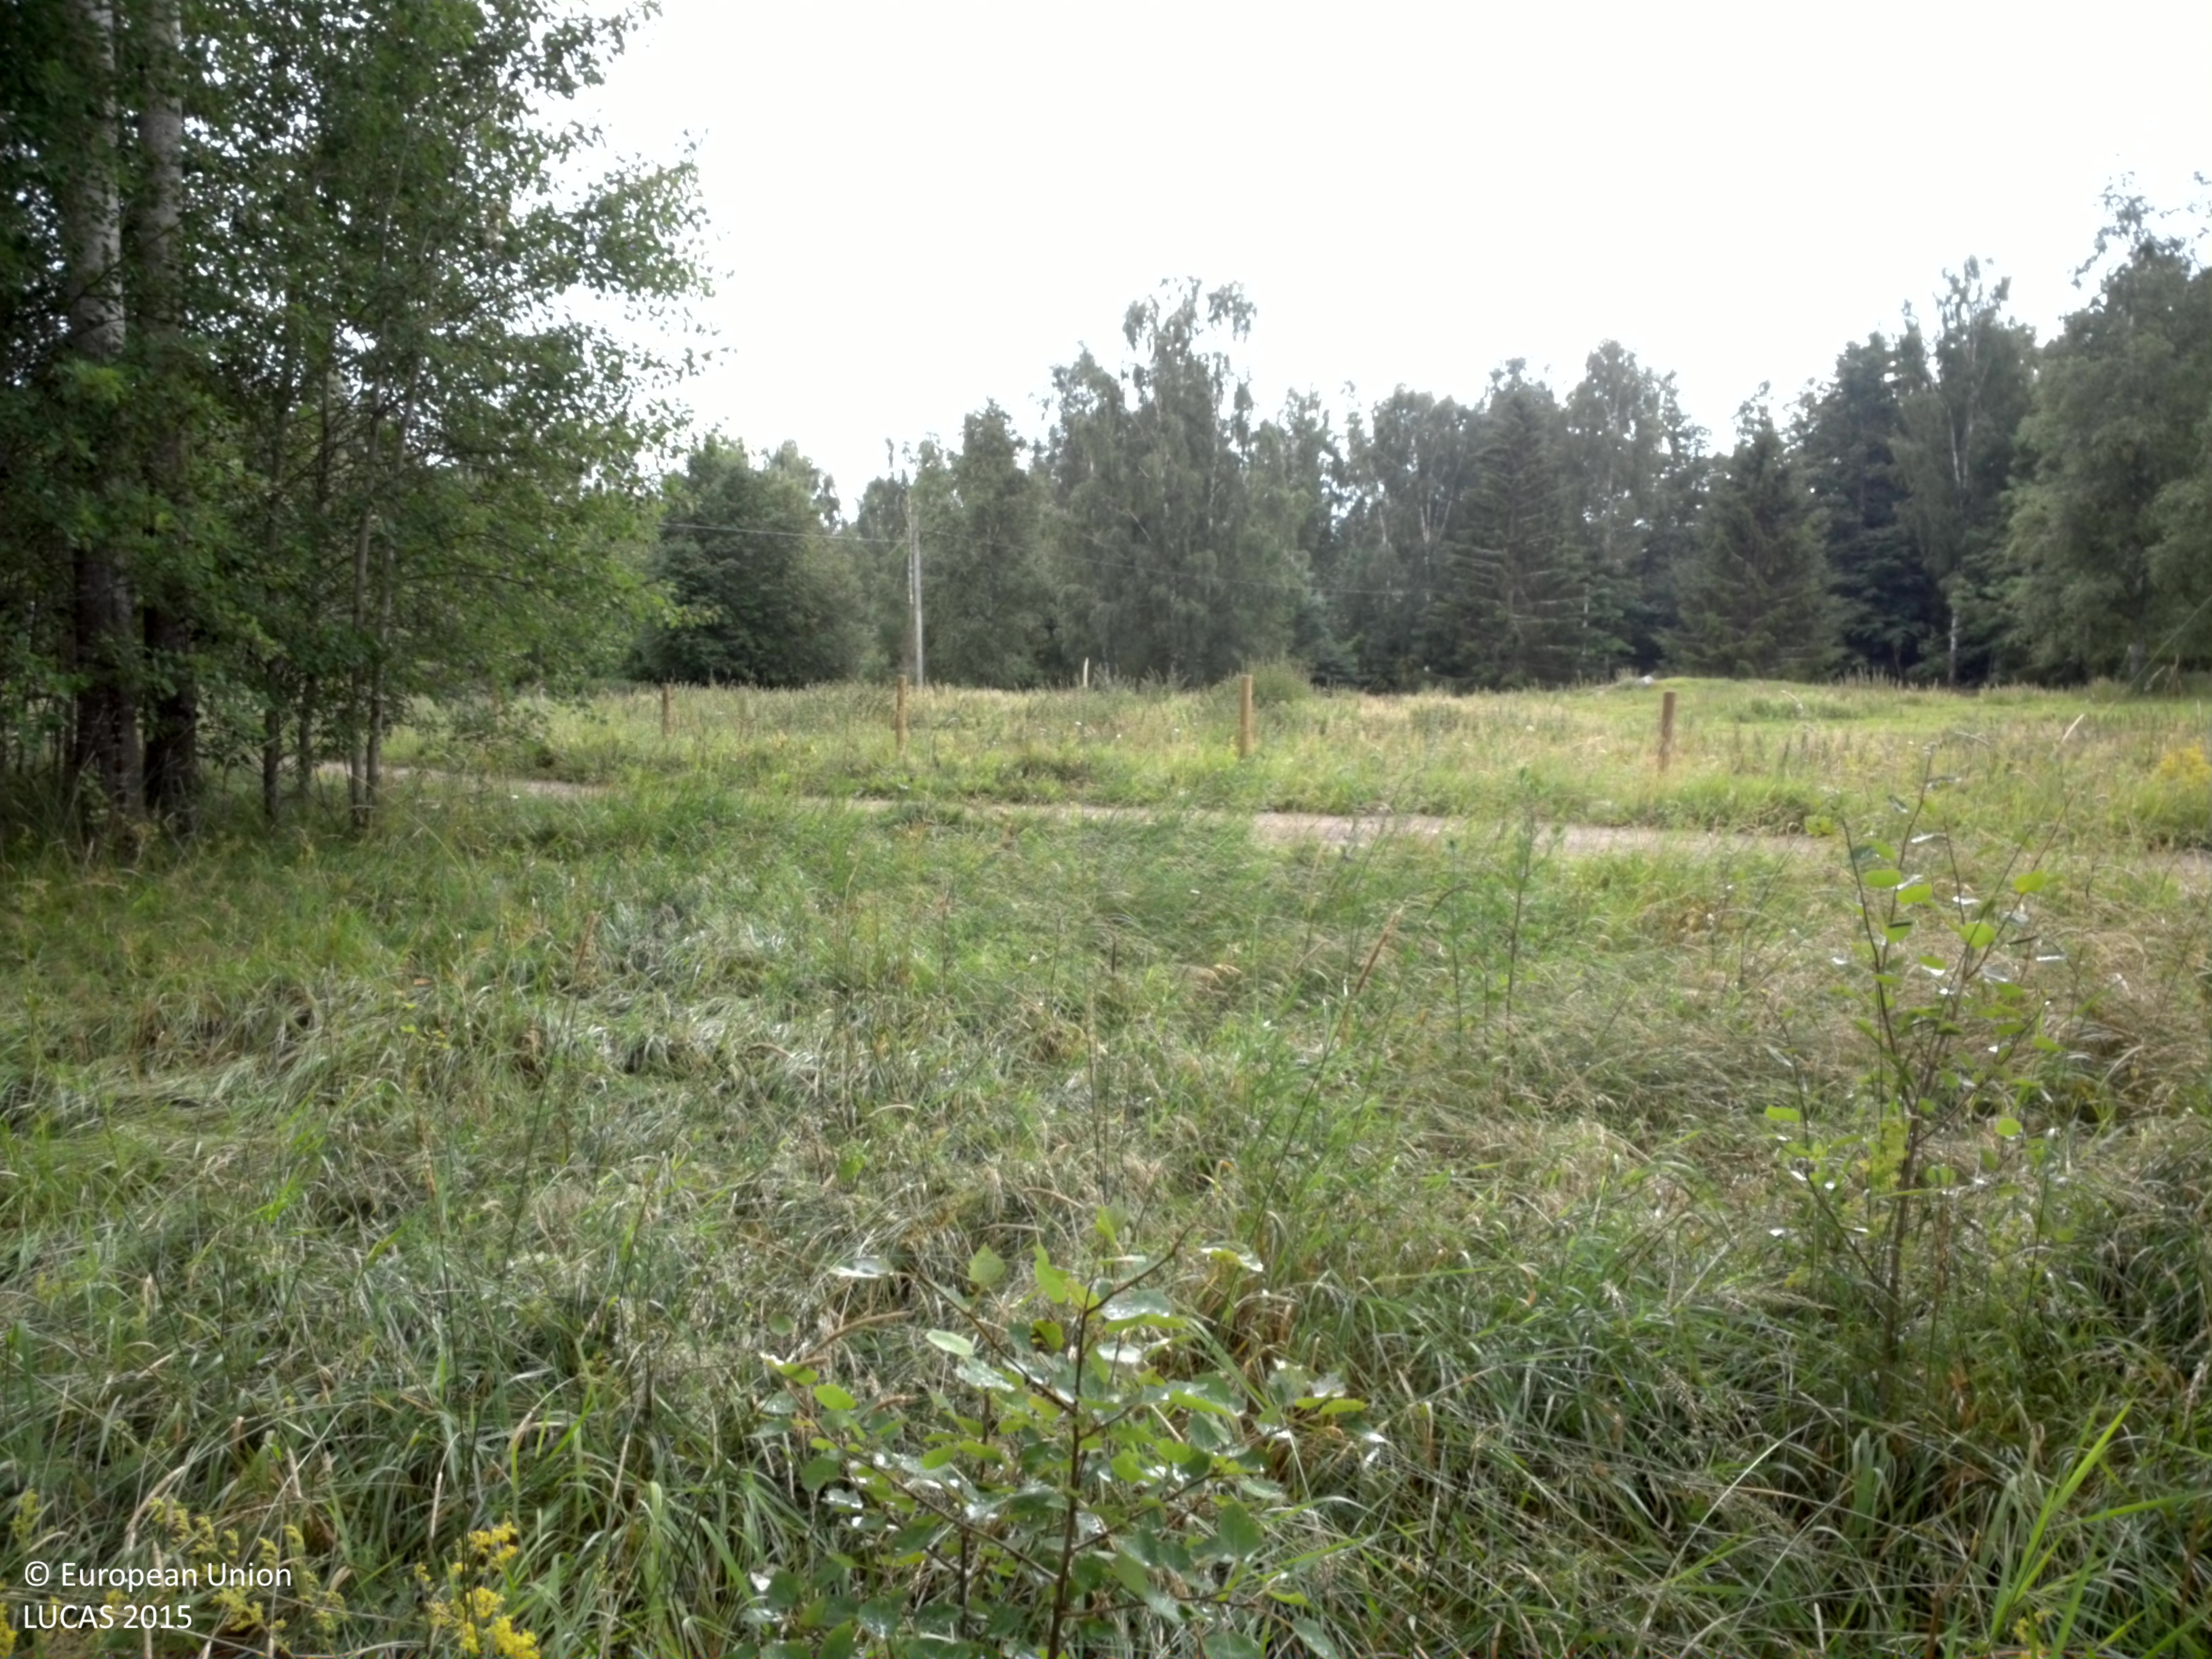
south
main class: Woodland
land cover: Broadleaved woodland
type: hemiboreal forest and nemoral coniferous forest and mixed broadleaved-coniferous forest
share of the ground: 25 - 50 %
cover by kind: broadleaved forest trees 50 %, herbaceous plants 50 %
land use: Semi-natural and natural areas not in use
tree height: > 5 m
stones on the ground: < 10 %
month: July
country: SE
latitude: 59.9734
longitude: 18.5799
